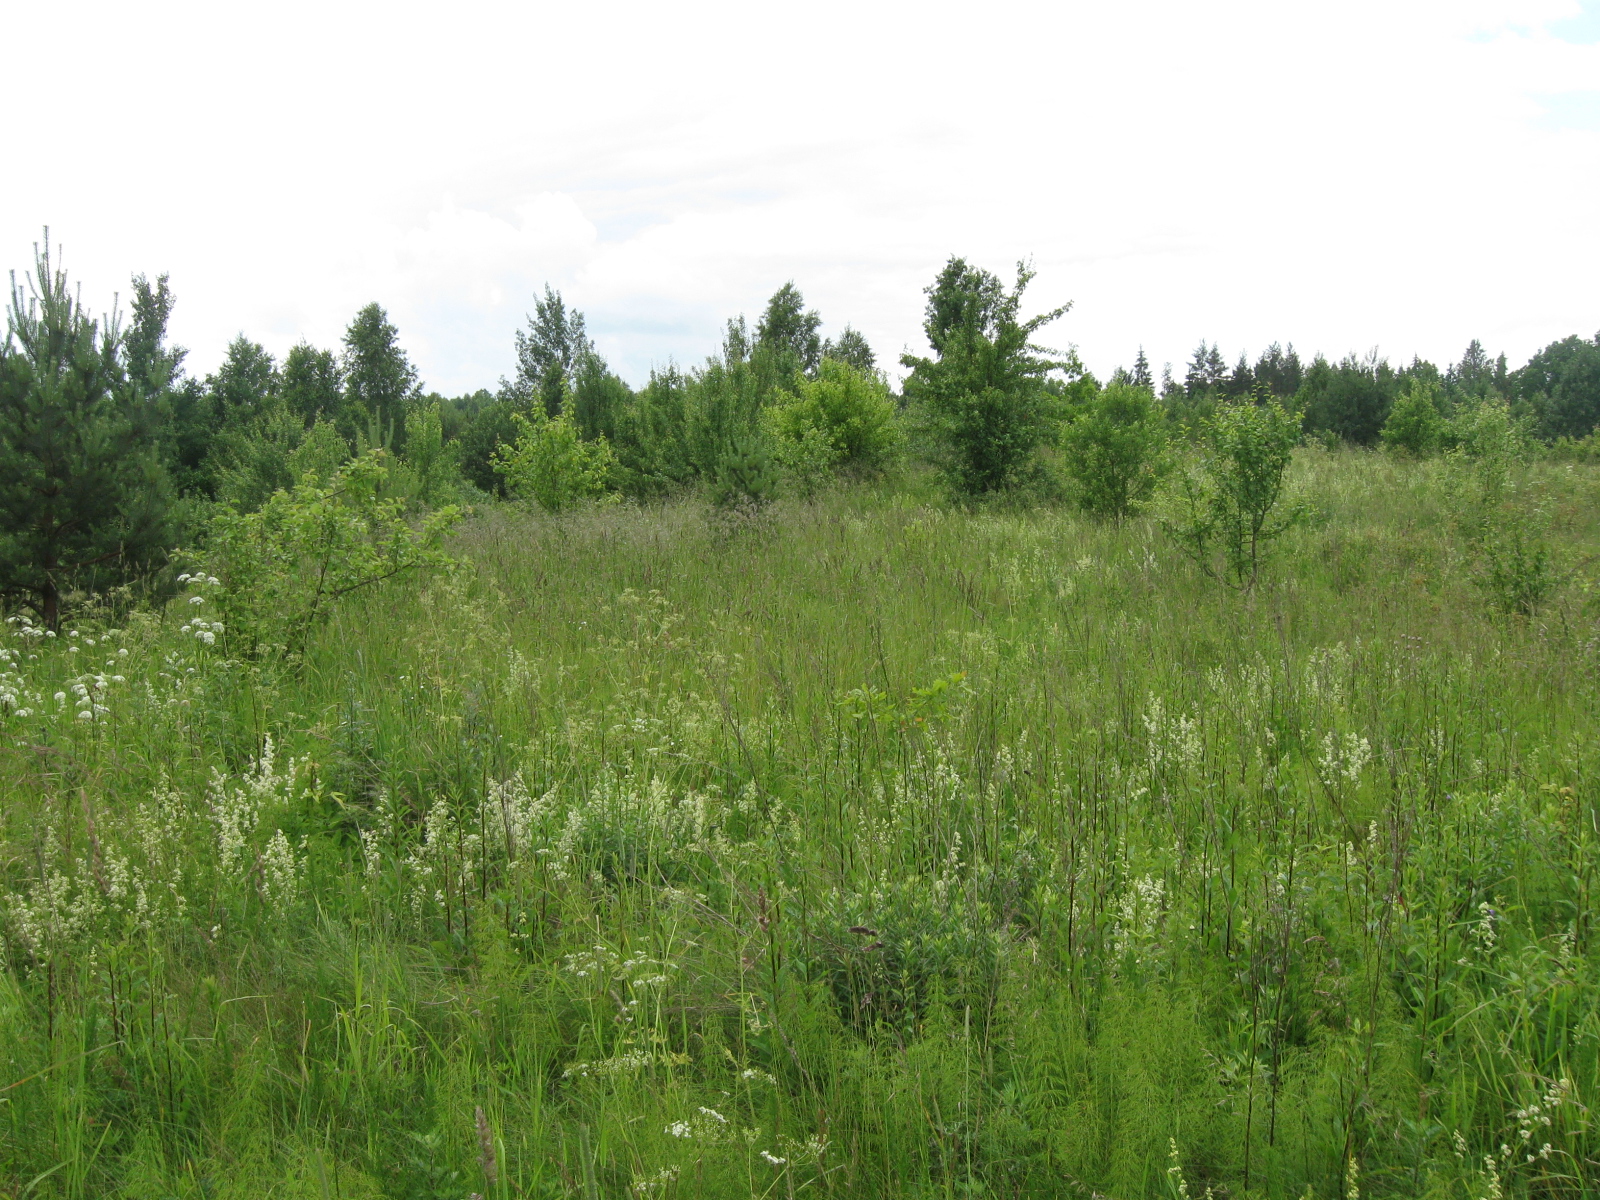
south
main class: Grassland
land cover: Grassland with sparse tree/shrub cover
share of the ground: > 75 %
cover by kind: herbaceous plants 90 %, broadleaved forest trees 5 %, shrubs 5 %
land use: Agriculture (excluding fallow land and kitchen gardens)
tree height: < 5 m
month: June
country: LT
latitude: 54.5076
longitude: 24.4180
